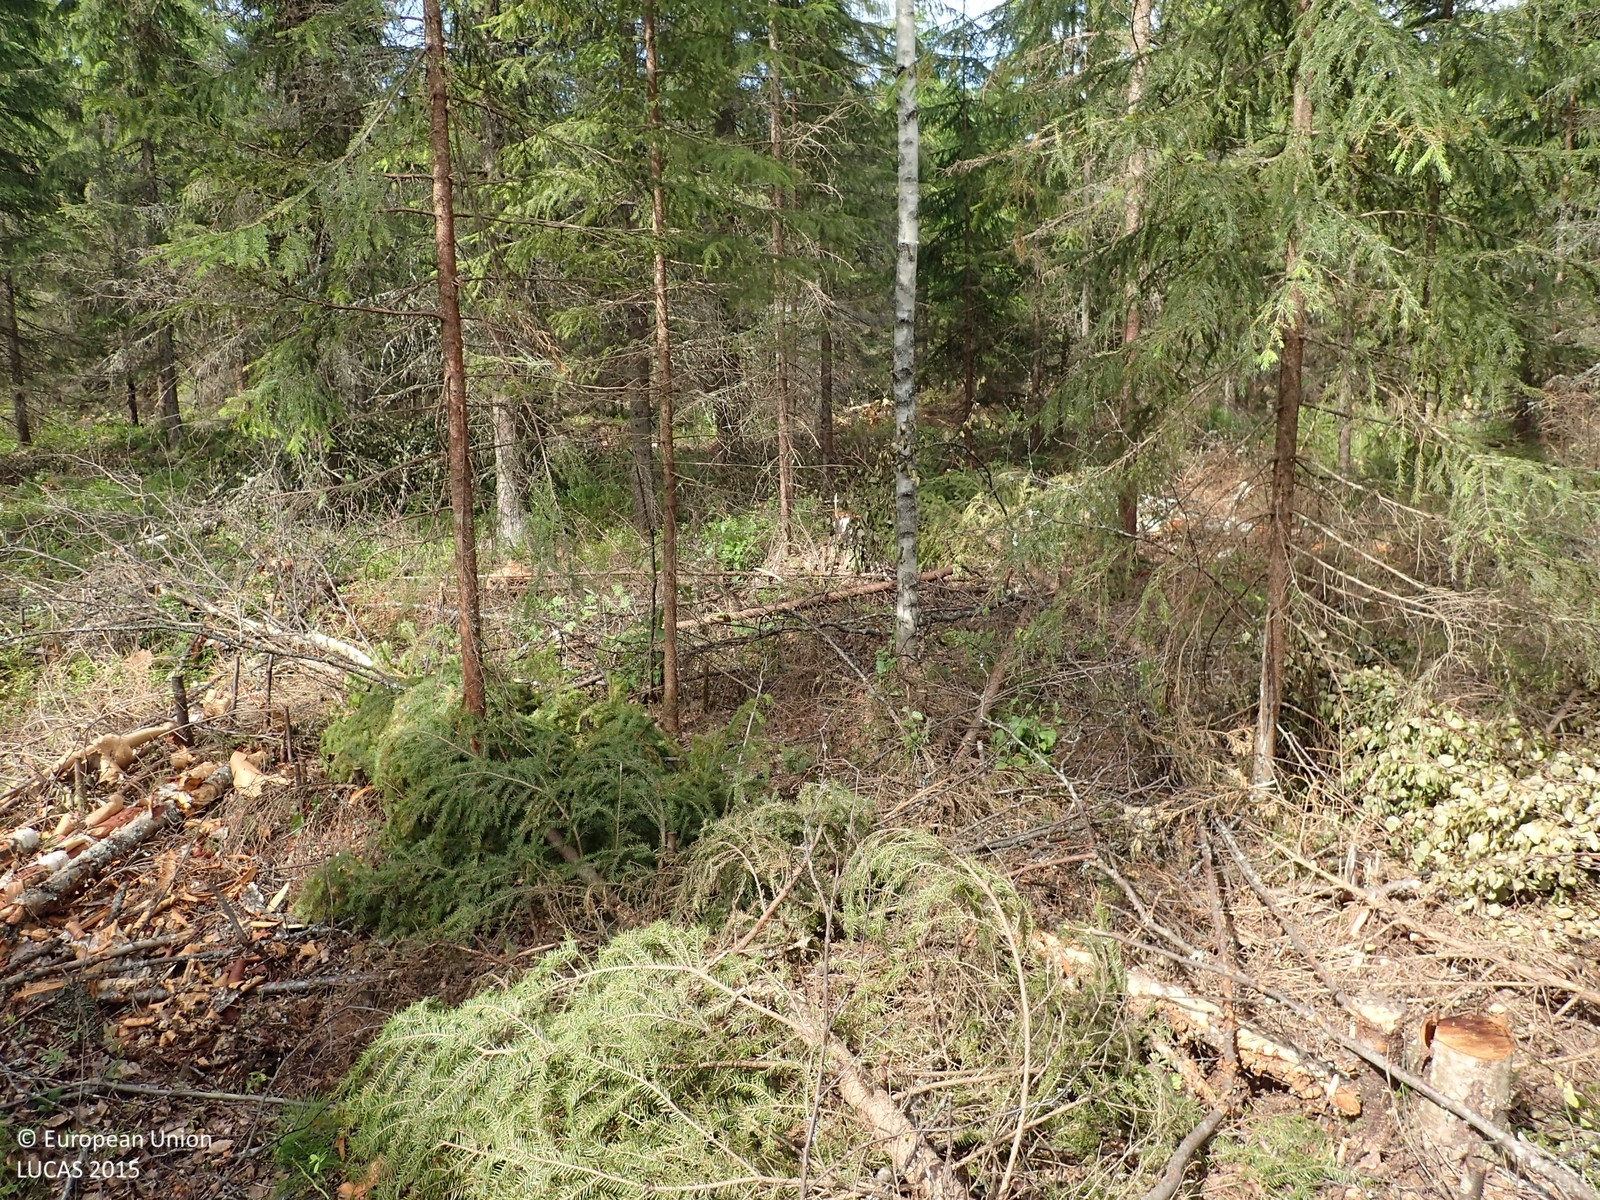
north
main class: Woodland
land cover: Spruce dominated coniferous woodland
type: boreal forest
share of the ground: 25 - 50 %
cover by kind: unconsolidated bare surface 50 %, coniferous forest trees 30 %, shrubs 15 %, broadleaved forest trees 5 %
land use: Forestry
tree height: > 5 m
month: July
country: FI
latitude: 62.9589
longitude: 21.4549
